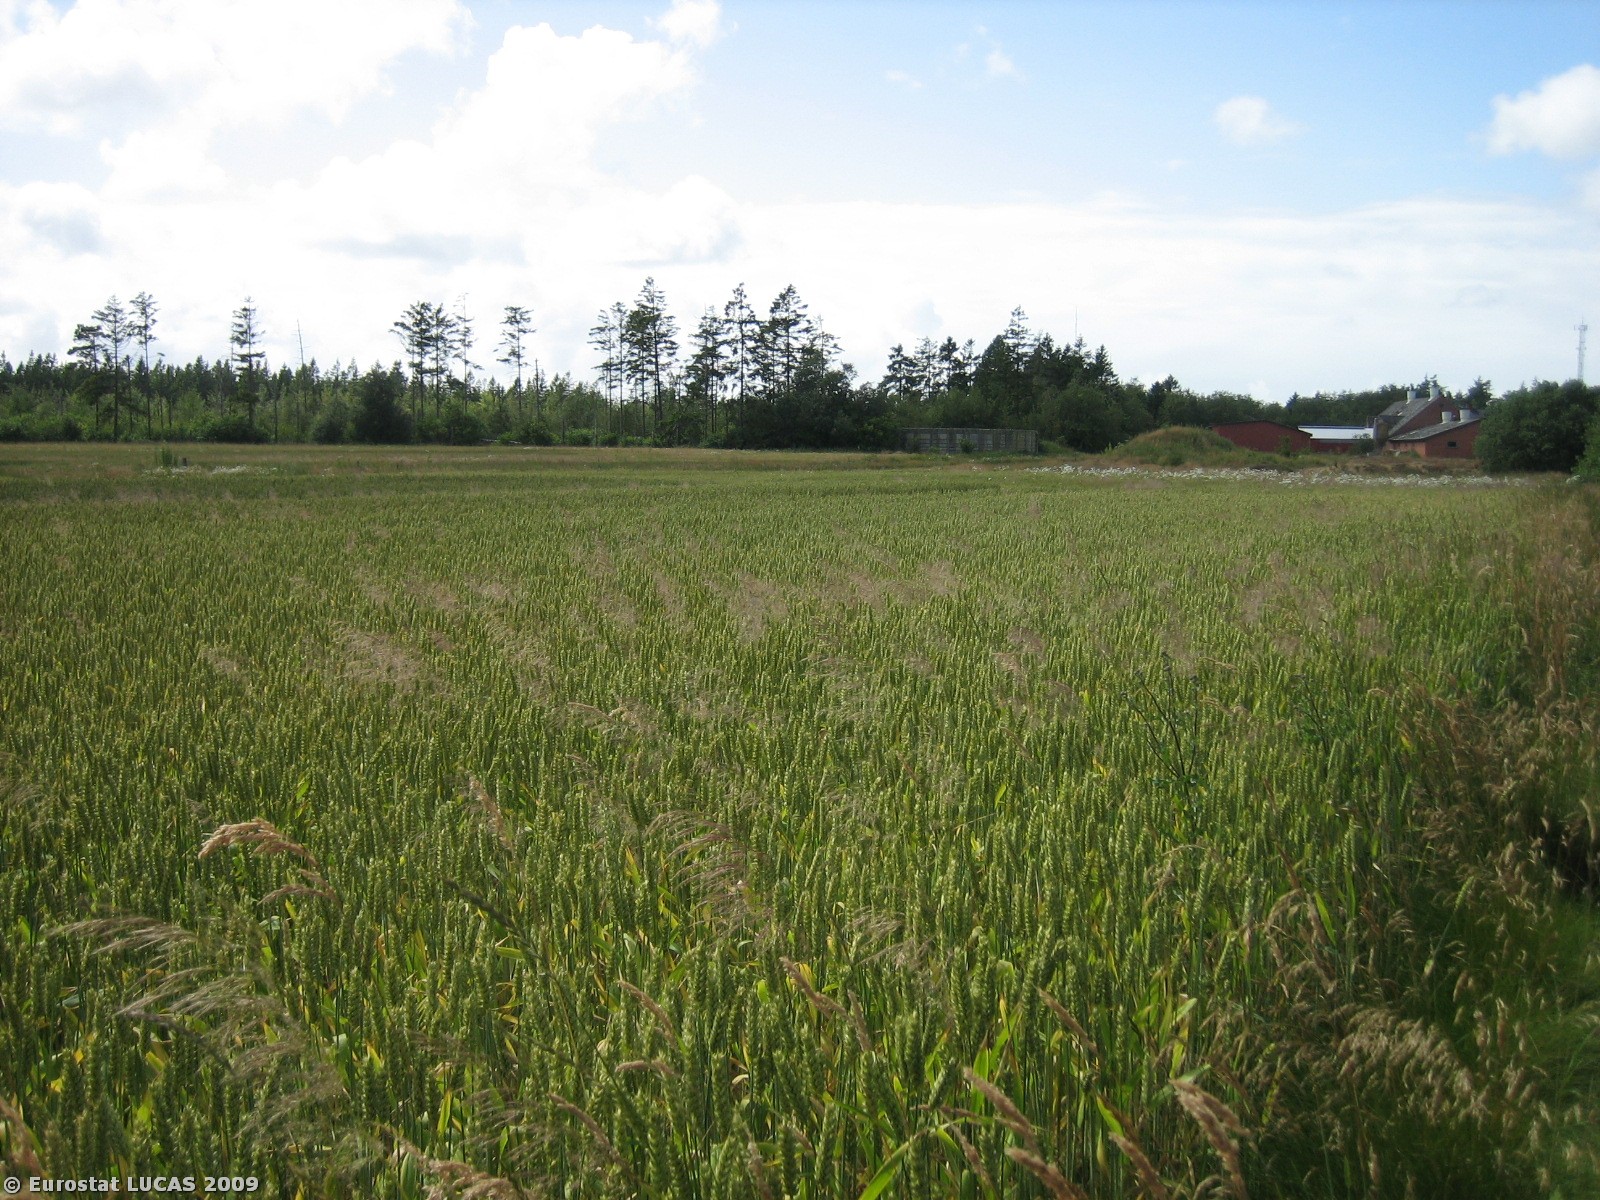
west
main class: Cropland
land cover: Common wheat
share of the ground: > 75 %
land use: Agriculture (excluding fallow land and kitchen gardens)
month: July
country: DK
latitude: 55.9098
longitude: 8.5457
